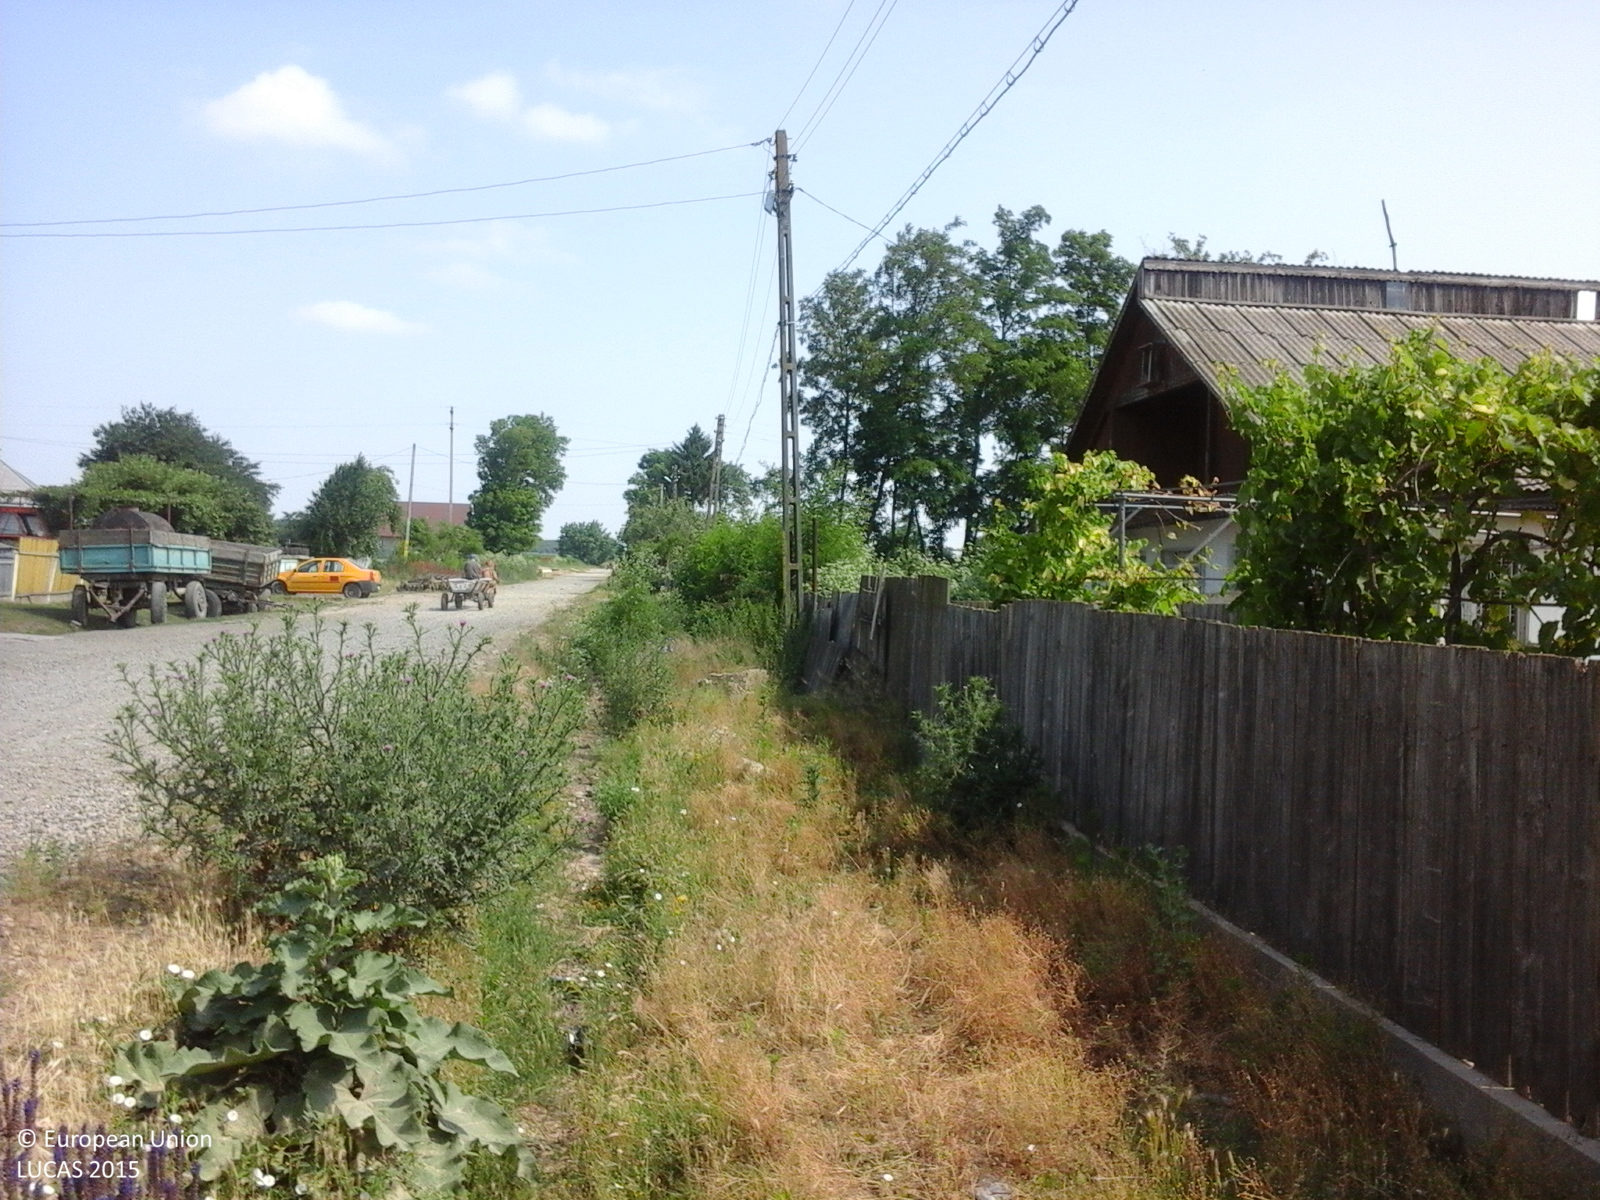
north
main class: Grassland
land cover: Grassland without tree/shrub cover
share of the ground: > 75 %
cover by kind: herbaceous plants 100 %
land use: Residential
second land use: Agriculture (excluding fallow land and kitchen gardens)
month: June
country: RO
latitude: 46.7437
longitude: 26.9952
